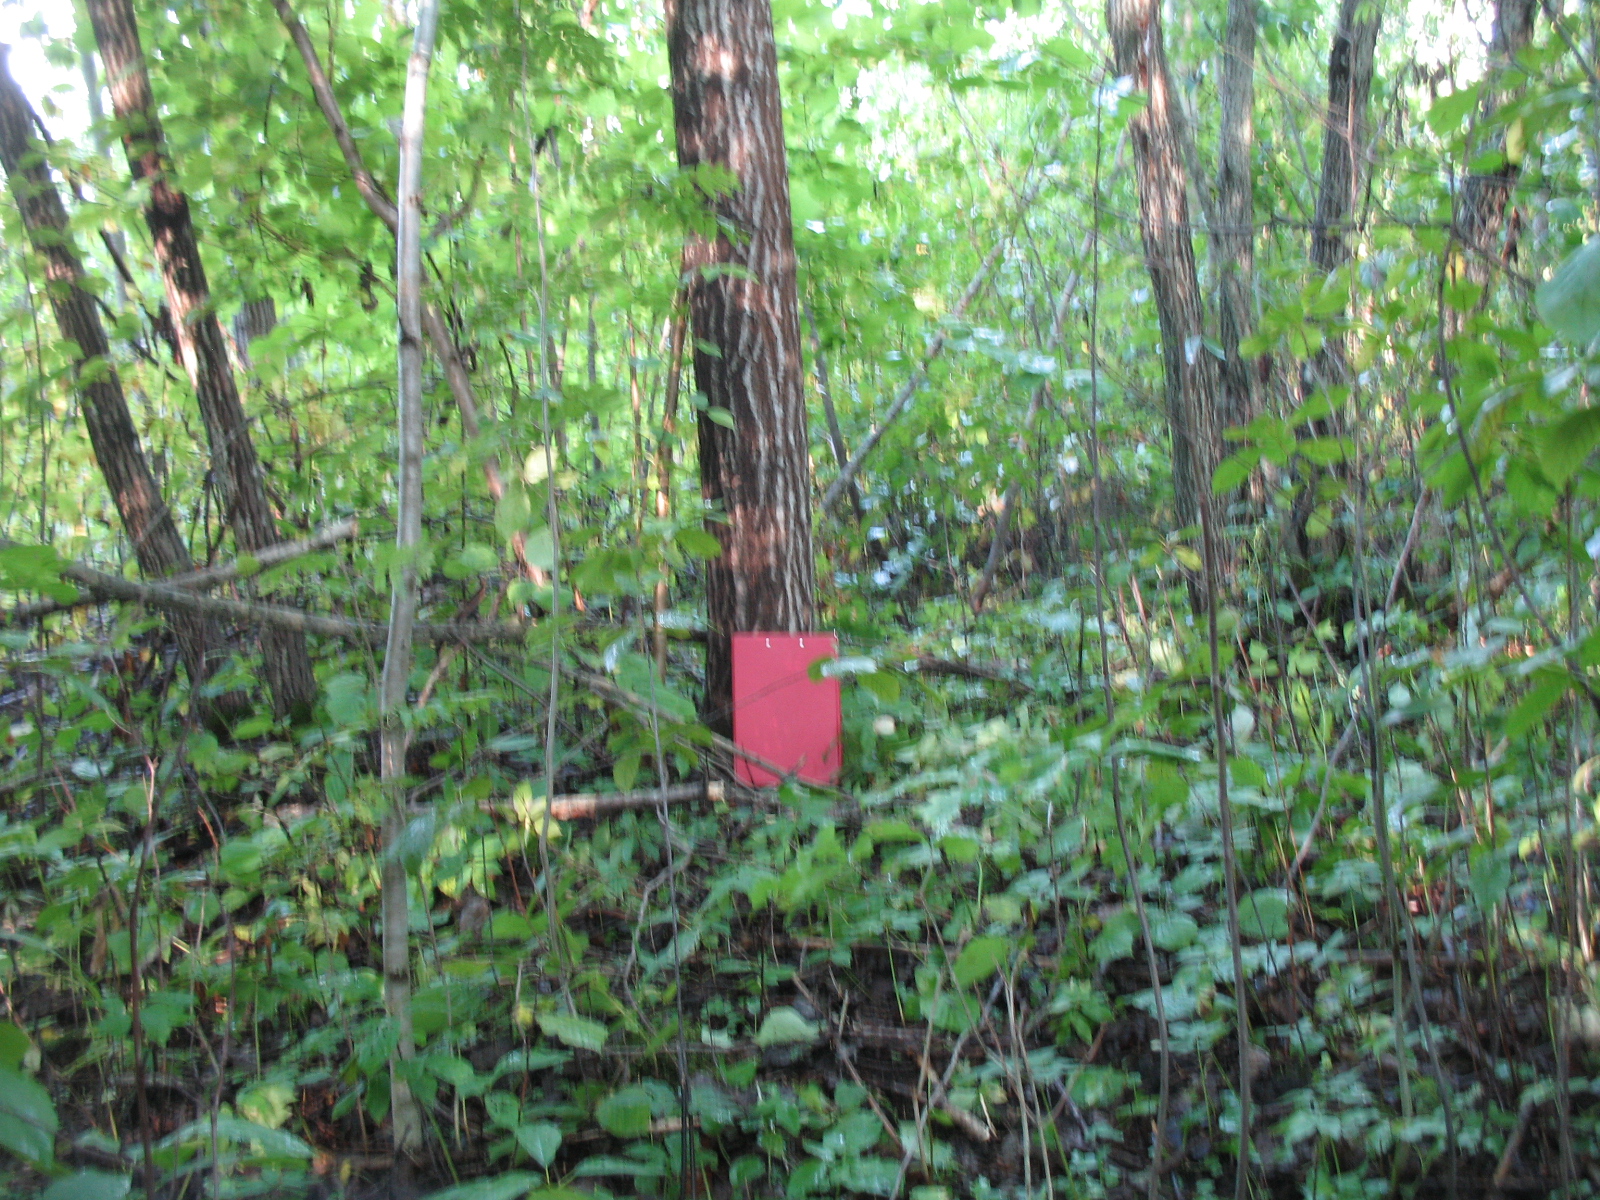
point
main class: Woodland
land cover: Broadleaved woodland
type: non-riverine alder, birch or aspen forest
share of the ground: > 75 %
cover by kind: broadleaved forest trees 90 %, shrubs 5 %, herbaceous plants 5 %
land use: Forestry
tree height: > 5 m
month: September
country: LV
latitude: 56.1418
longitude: 25.7556
